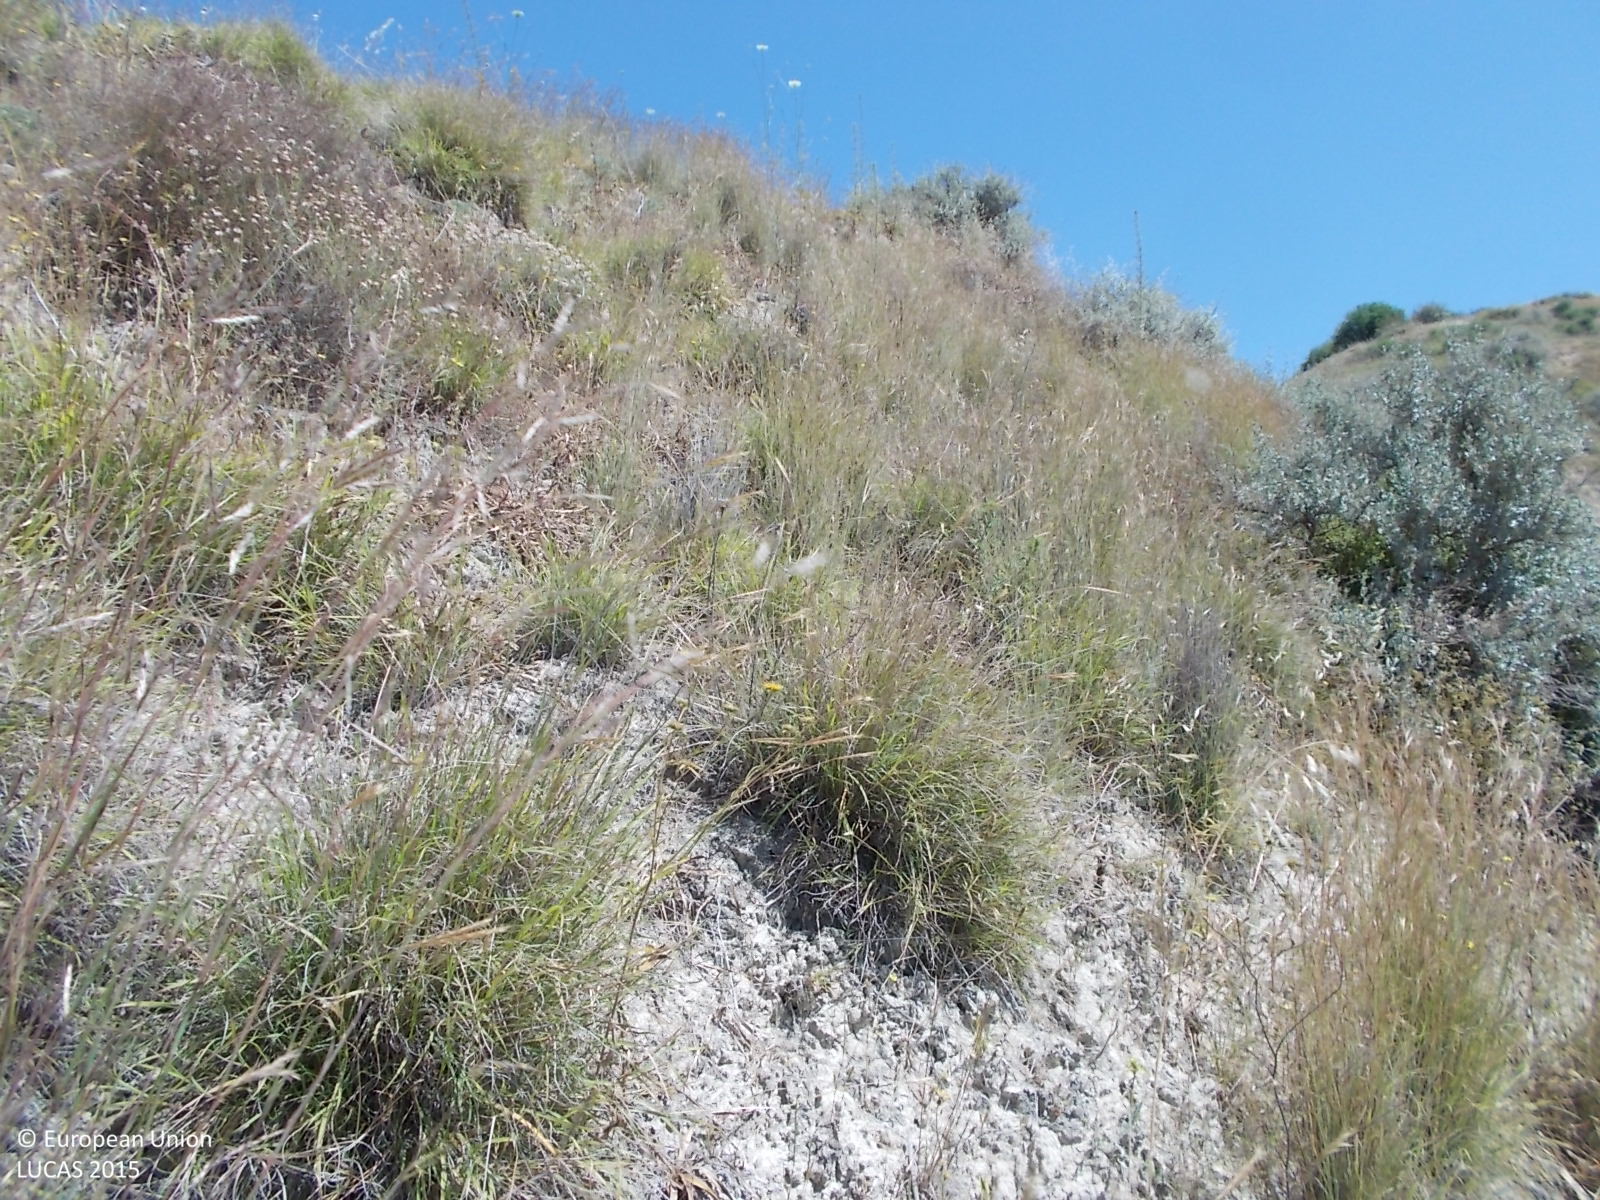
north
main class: Shrubland
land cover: Shrubland without tree cover
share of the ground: > 75 %
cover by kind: shrubs 75 %, herbaceous plants 20 %, unconsolidated bare surface 5 %
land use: Semi-natural and natural areas not in use
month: May
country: CY
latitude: 34.9445
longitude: 32.4781
